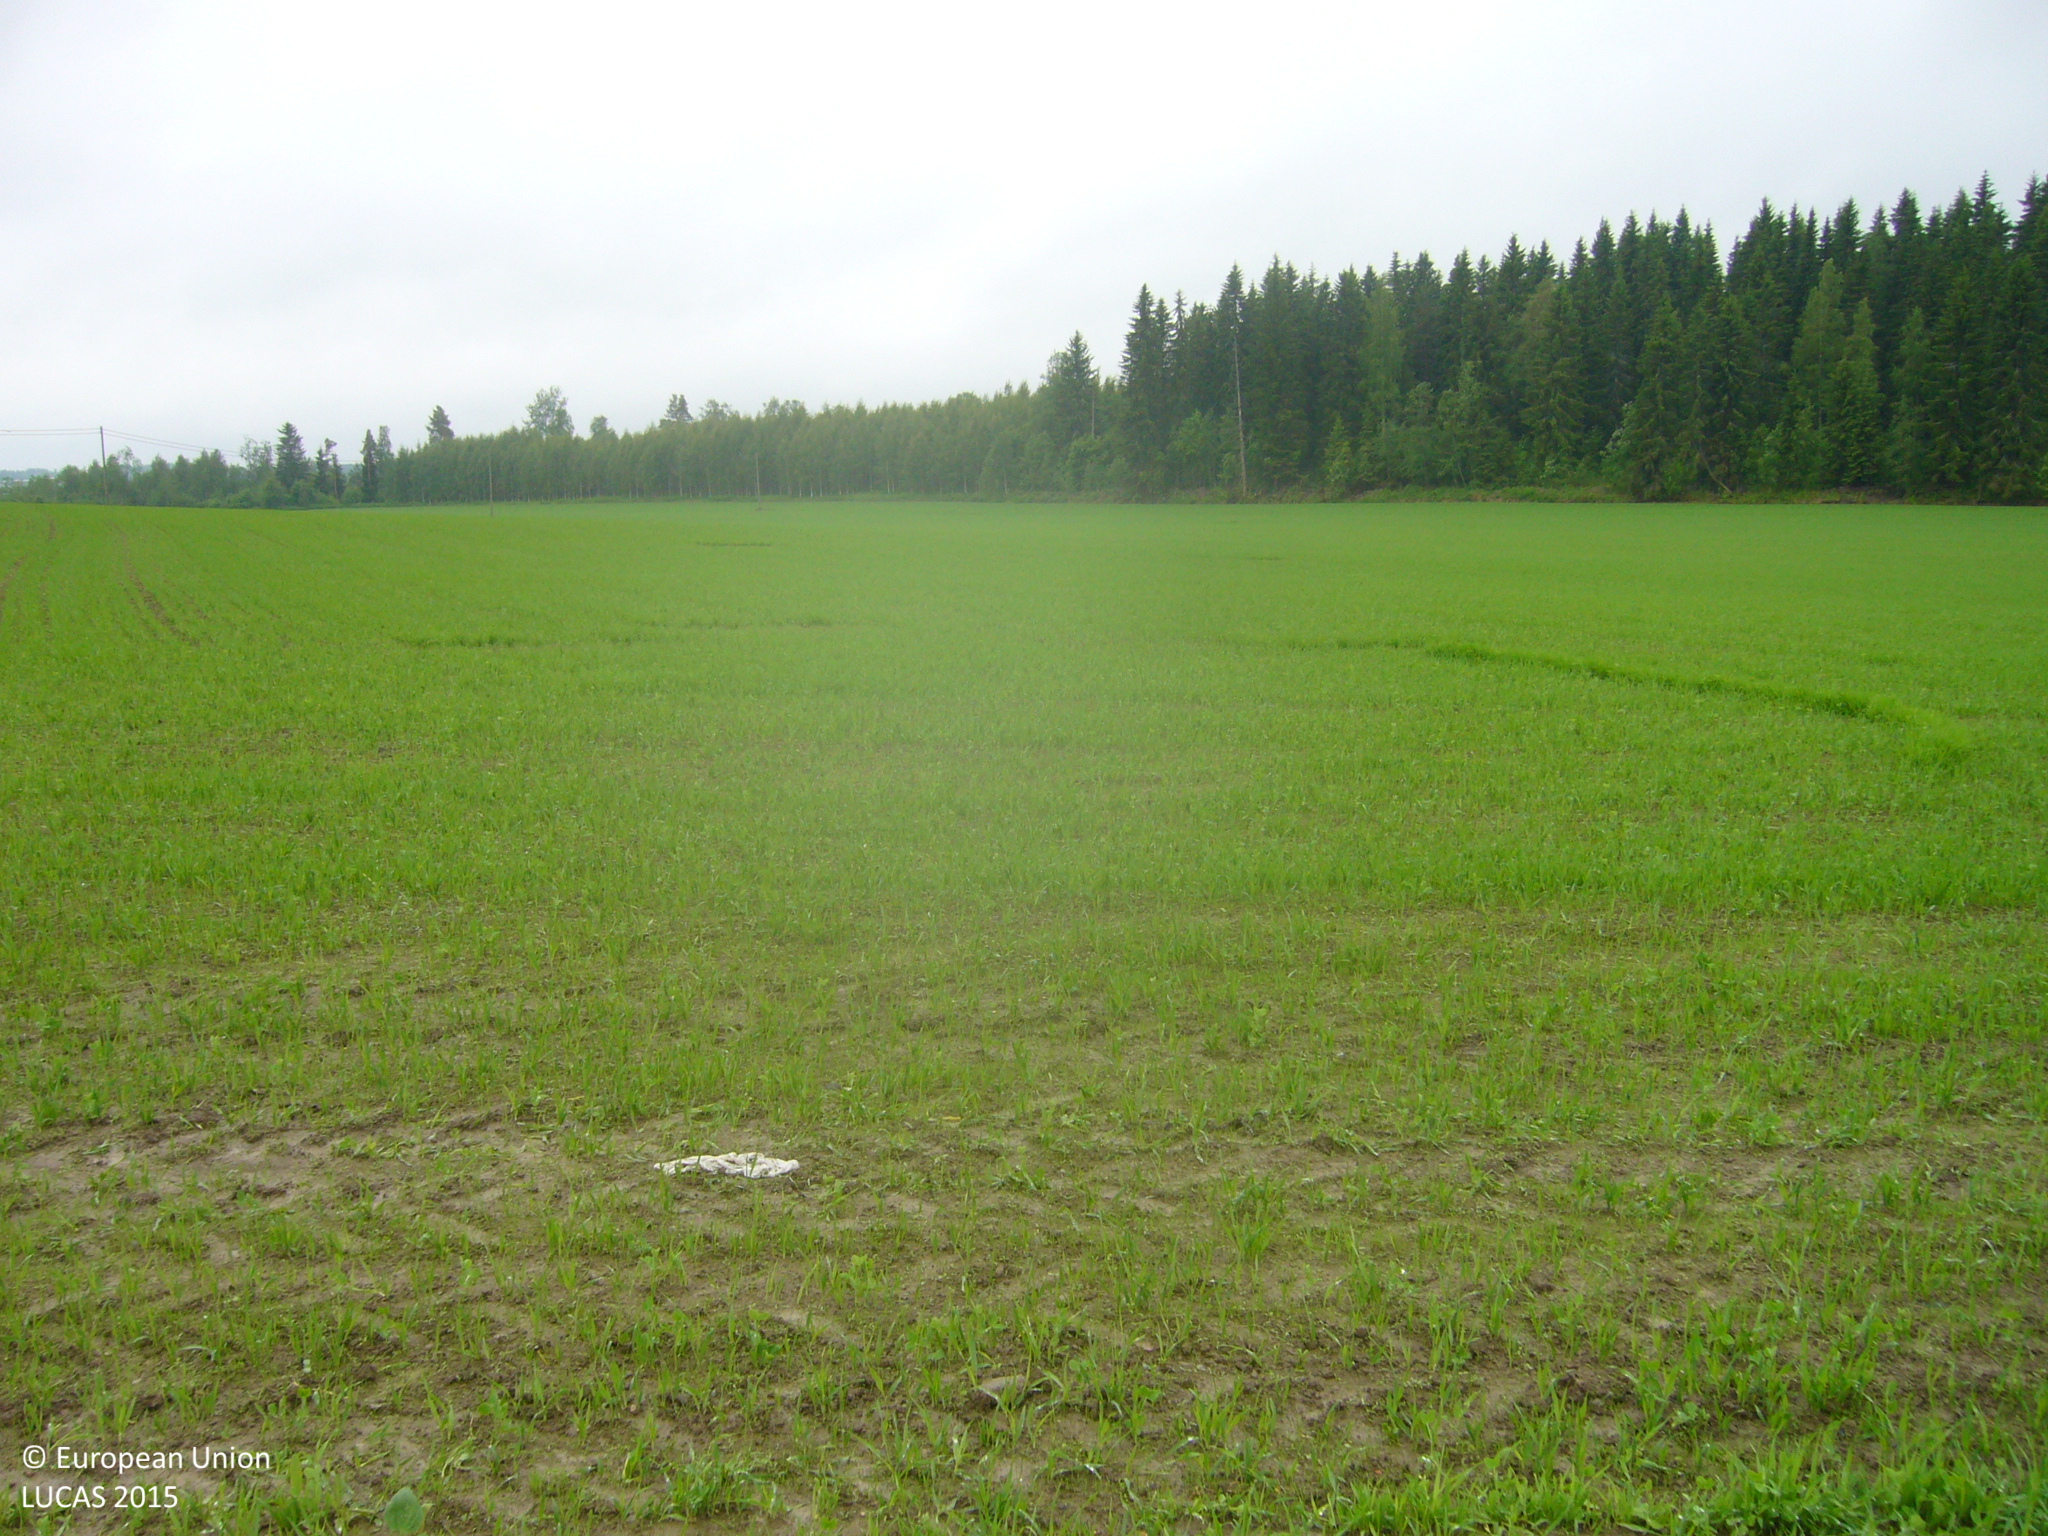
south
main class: Cropland
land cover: Barley
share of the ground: > 75 %
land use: Agriculture (excluding fallow land and kitchen gardens)
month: June
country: FI
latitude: 63.6585
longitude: 26.4655
